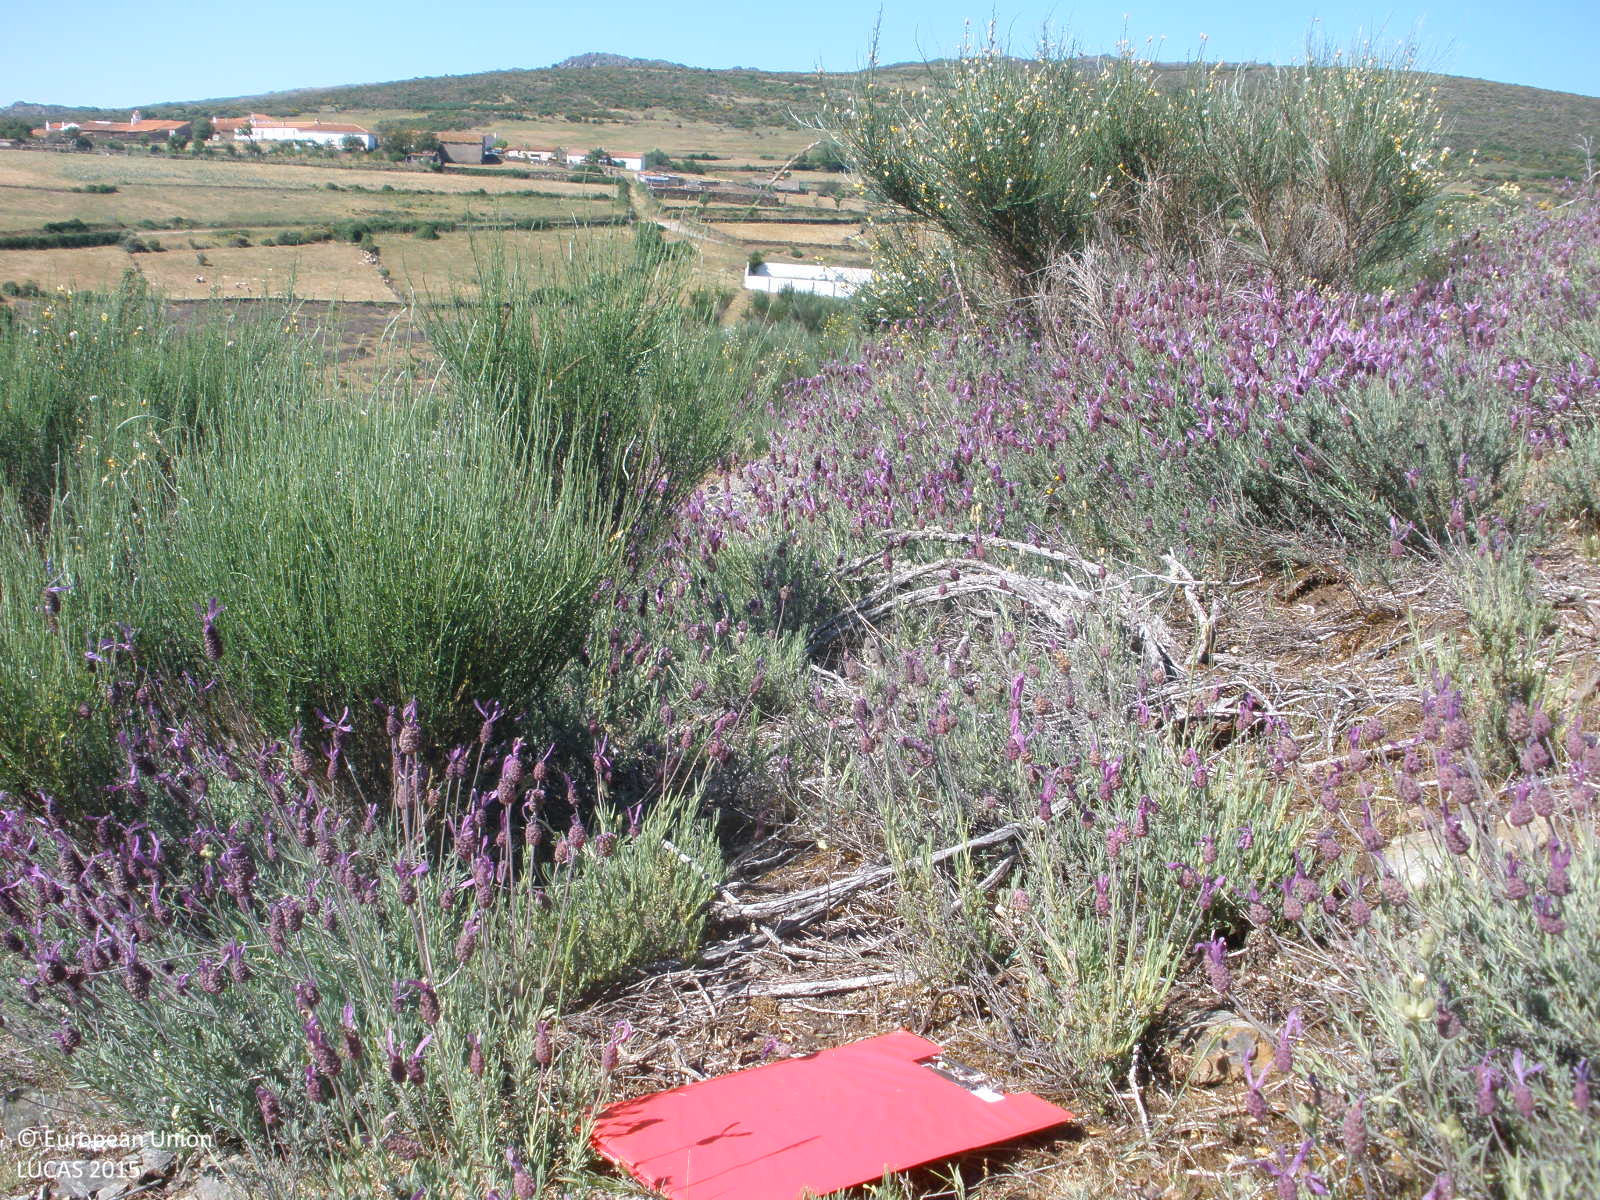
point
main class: Shrubland
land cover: Shrubland without tree cover
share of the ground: > 75 %
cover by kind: shrubs 80 %, herbaceous plants 20 %
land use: Agriculture (excluding fallow land and kitchen gardens)
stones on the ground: 25 - 50 %
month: May
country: ES
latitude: 40.5719
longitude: -6.0615
